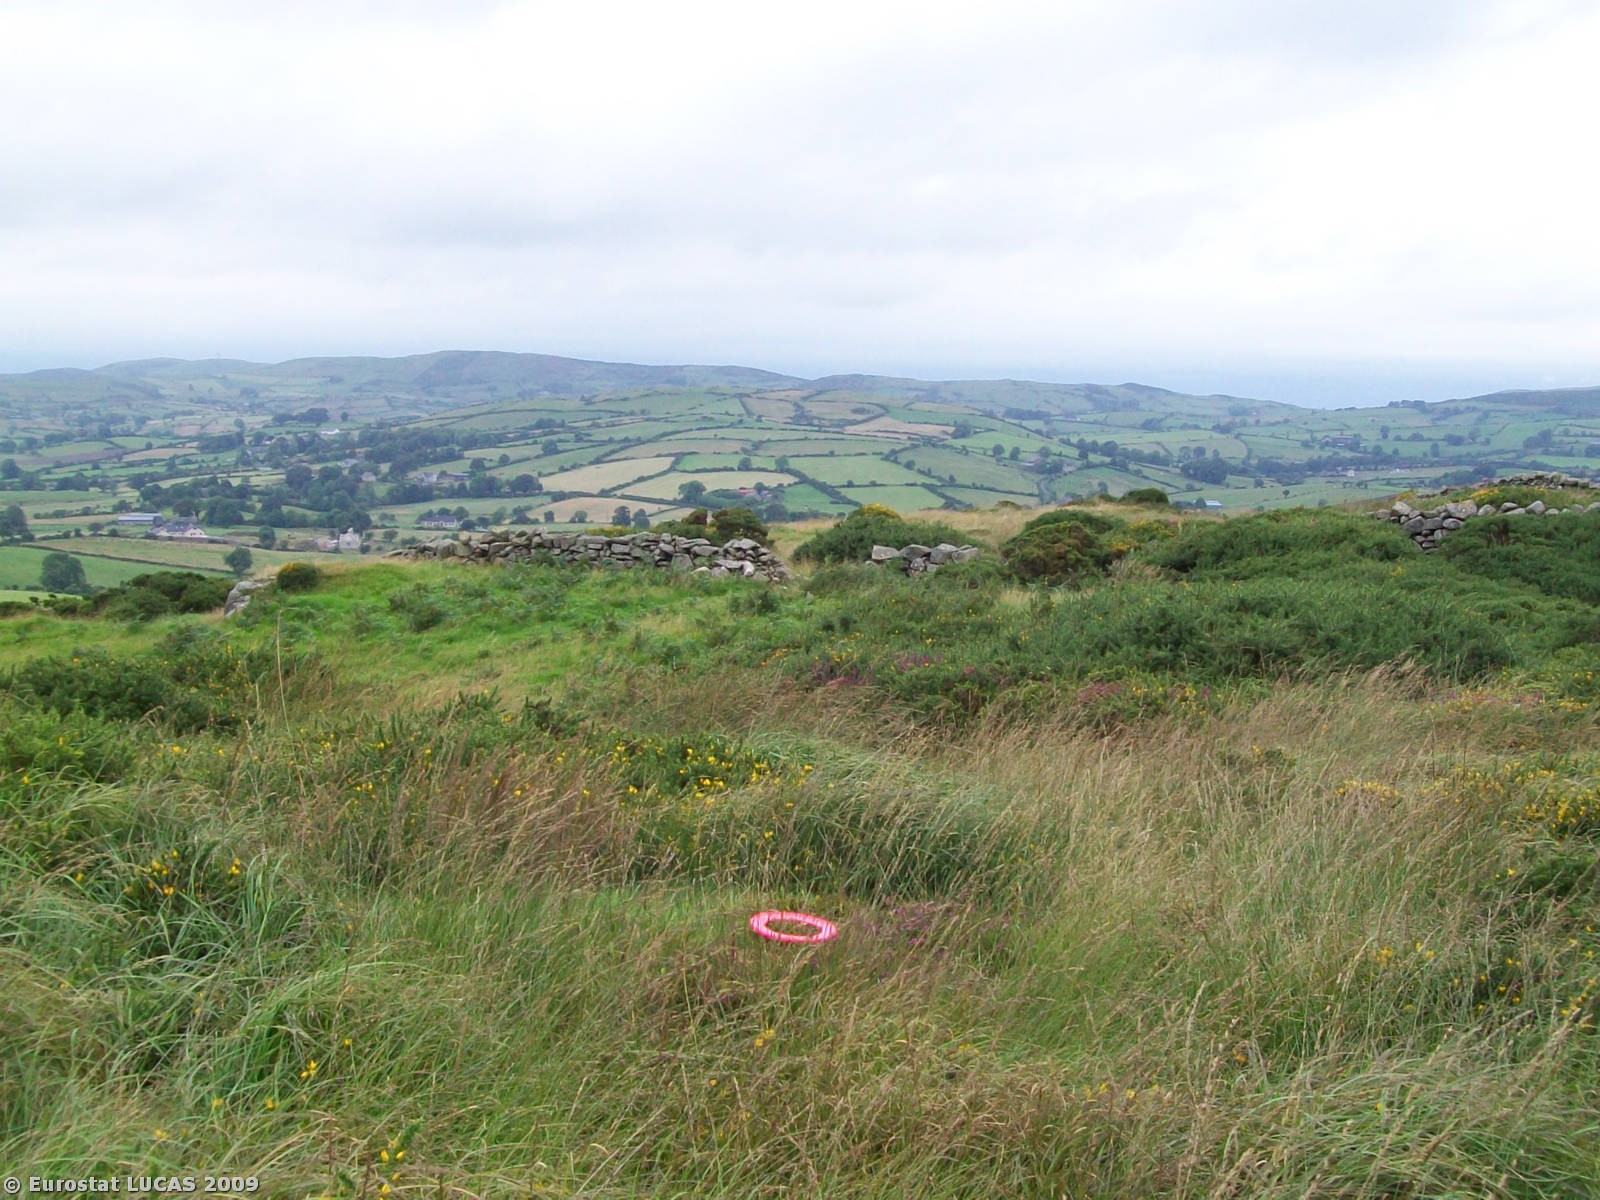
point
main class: Shrubland
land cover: Shrubland without tree cover
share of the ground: > 75 %
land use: Unused
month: August
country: GB
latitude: 54.2946
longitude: -5.9815
